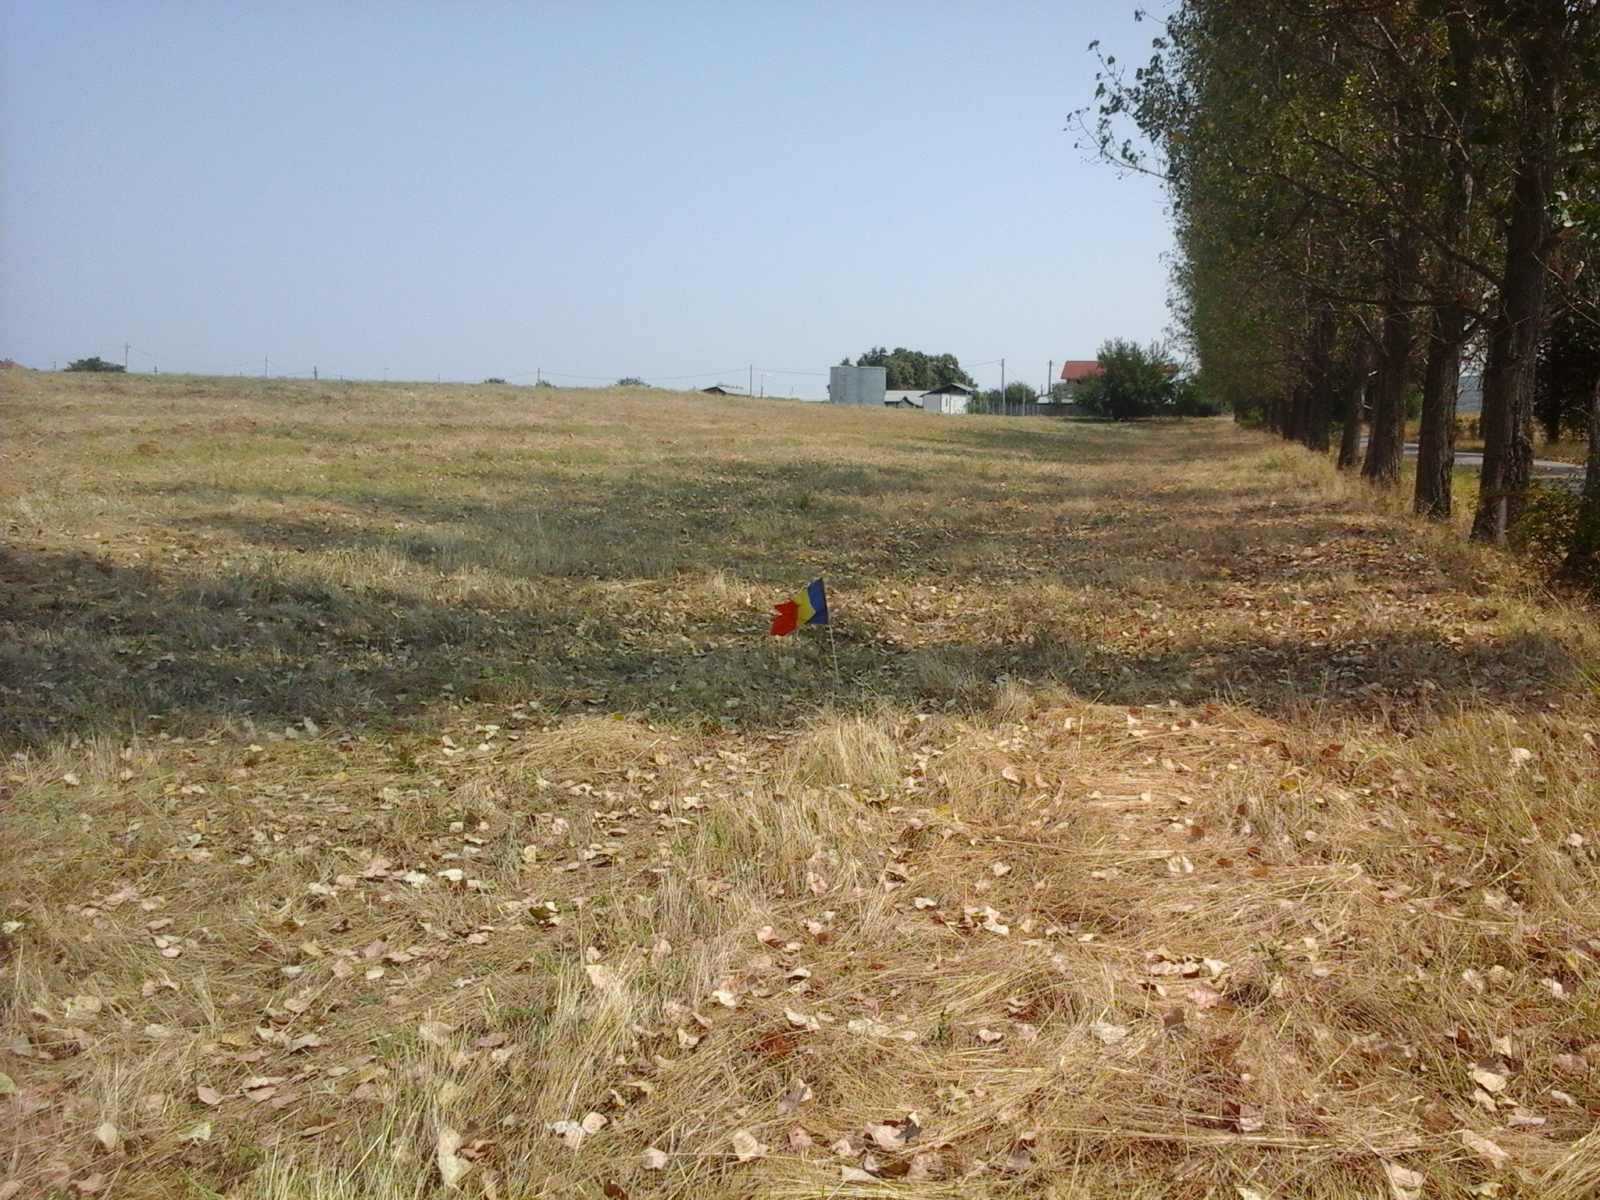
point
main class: Grassland
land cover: Grassland without tree/shrub cover
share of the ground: > 75 %
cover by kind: herbaceous plants 100 %
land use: Agriculture (excluding fallow land and kitchen gardens)
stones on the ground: < 10 %
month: August
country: RO
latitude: 44.5200
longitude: 22.6597
